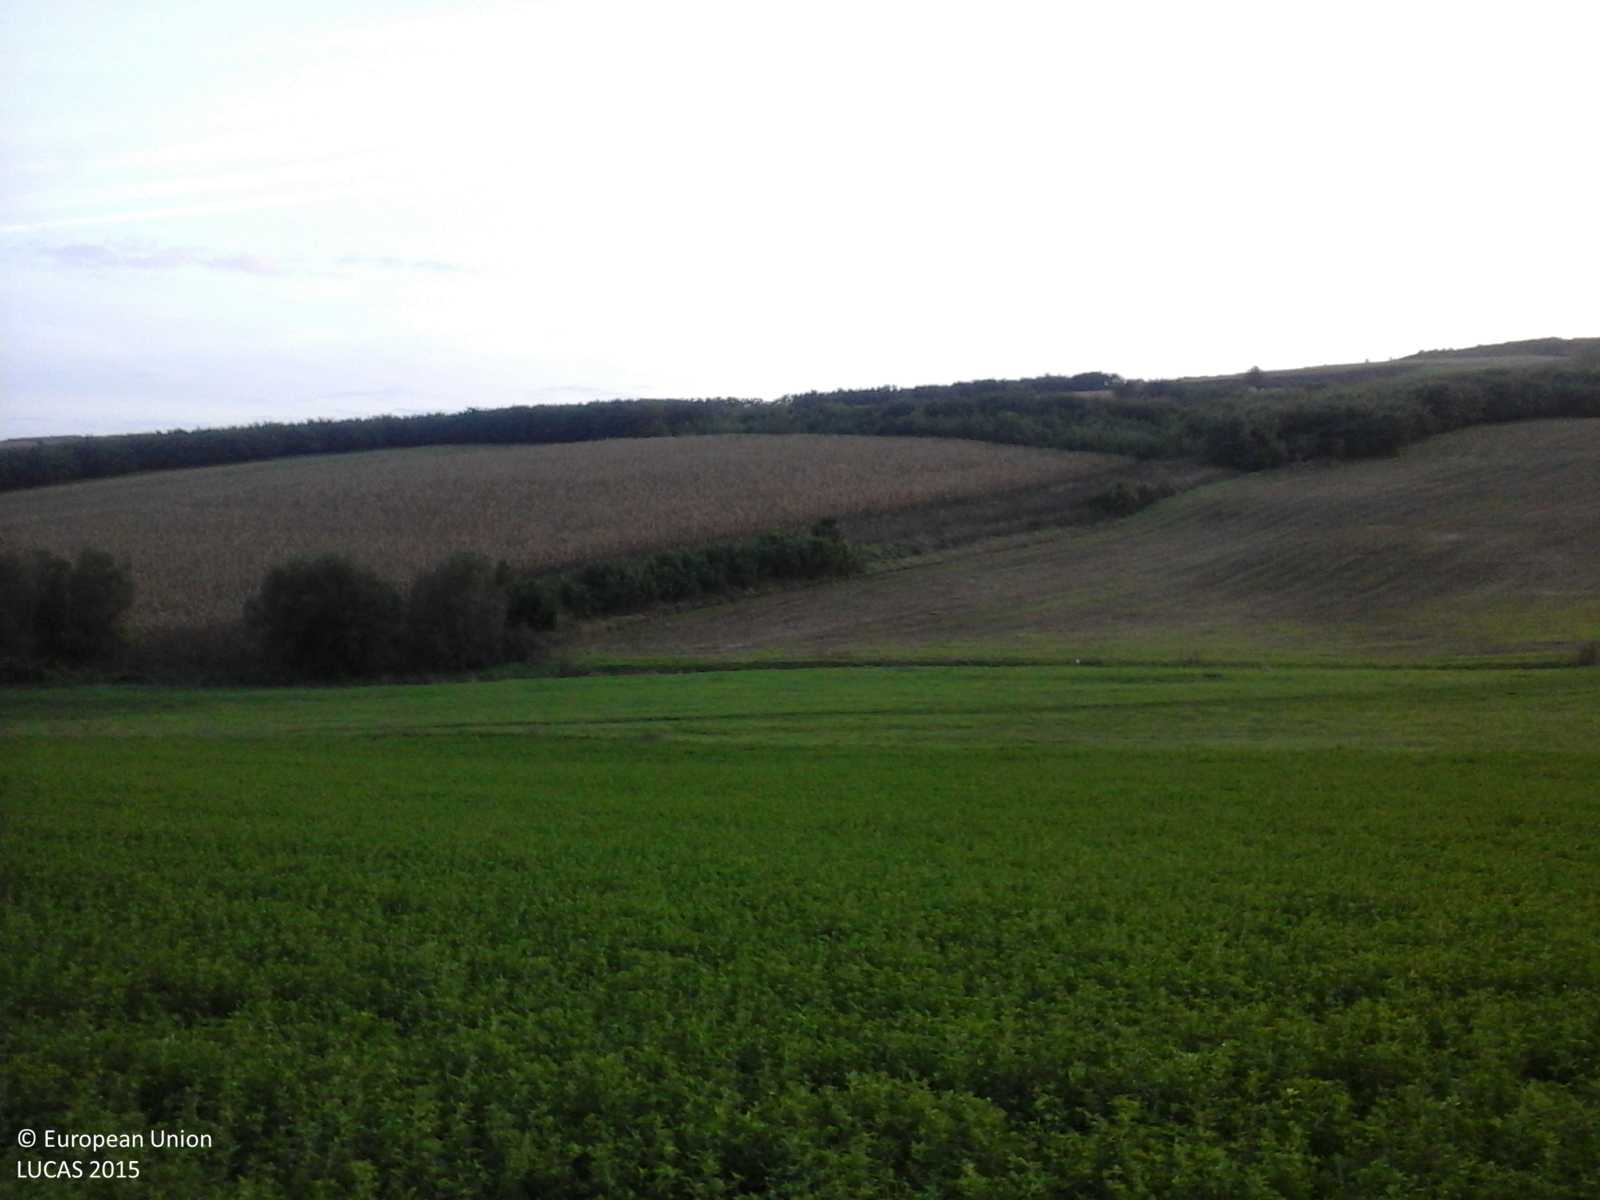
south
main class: Cropland
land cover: Lucerne
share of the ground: > 75 %
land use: Agriculture (excluding fallow land and kitchen gardens)
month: October
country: RO
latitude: 46.5911
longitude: 24.2970
